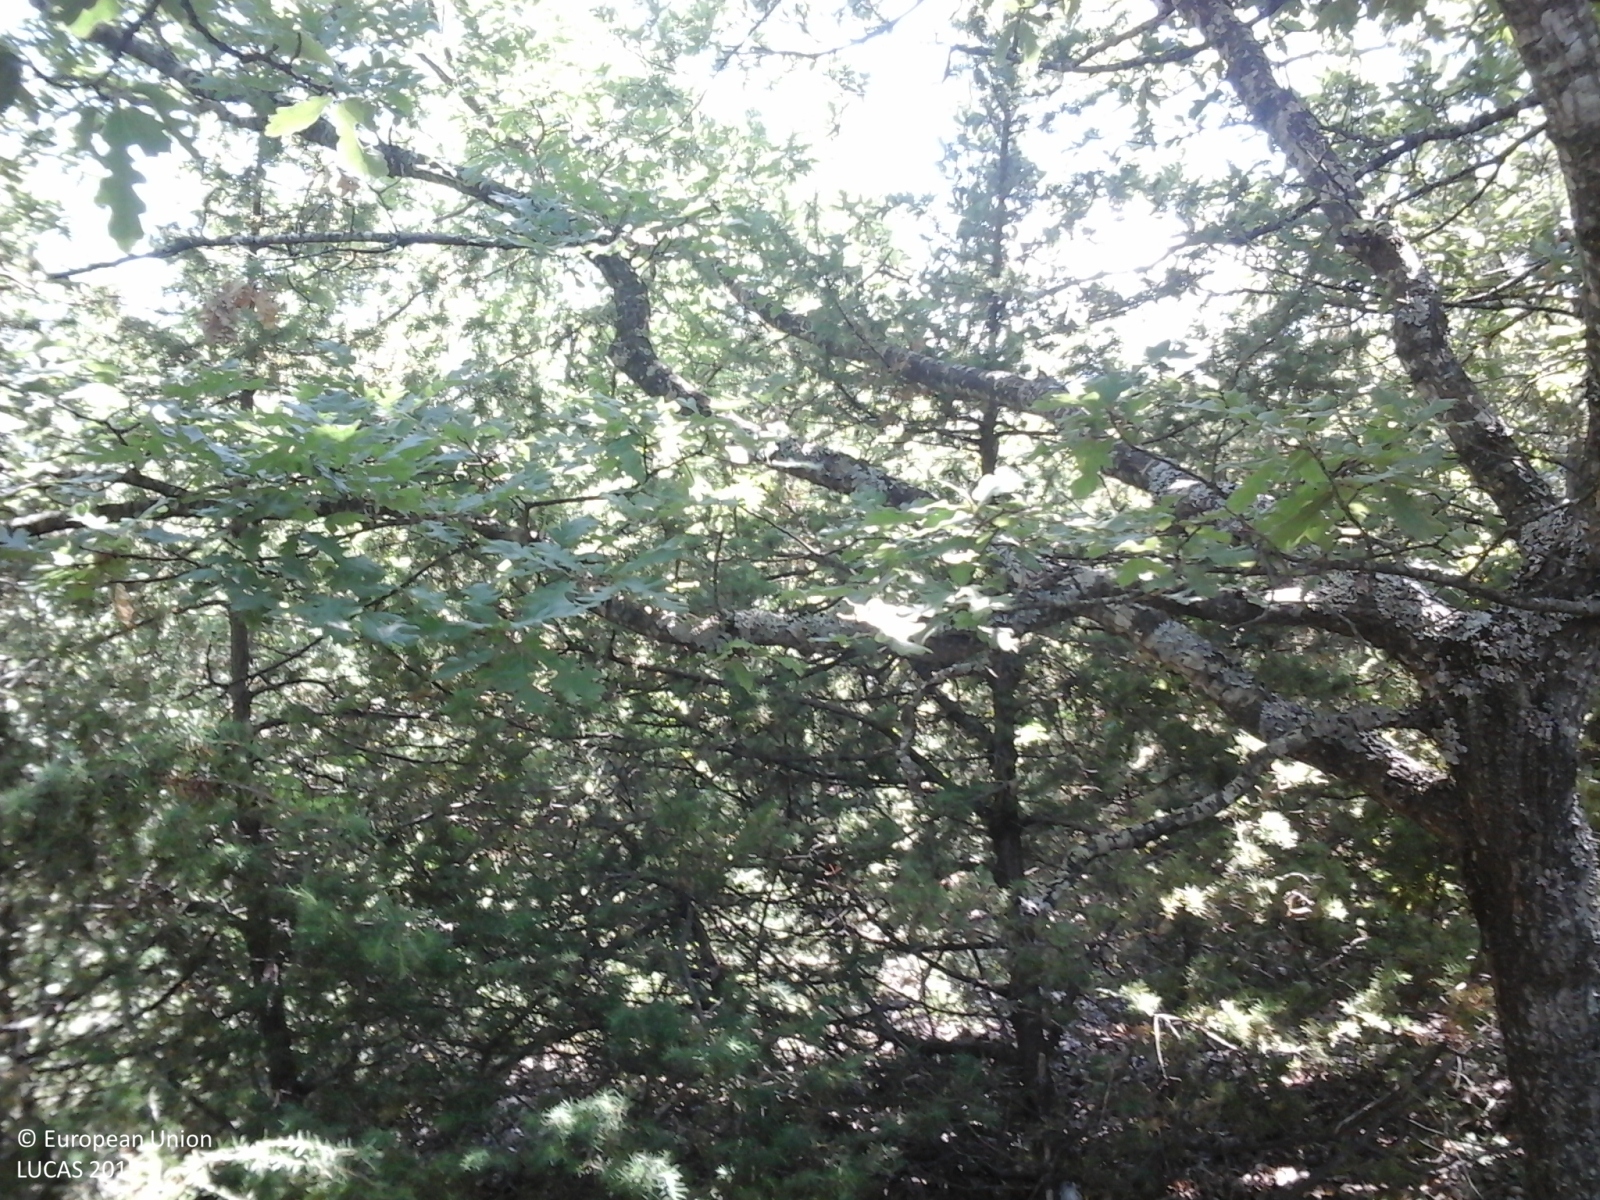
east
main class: Woodland
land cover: Broadleaved woodland
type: thermophilous deciduous forest
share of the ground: > 75 %
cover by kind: broadleaved forest trees 100 %
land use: Forestry
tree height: > 5 m
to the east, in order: Broadleaved woodland; Grassland without tree/shrub cover; Broadleaved woodland; Ditches and canals; Broadleaved woodland
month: June
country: IT
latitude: 42.7284
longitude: 13.2512
